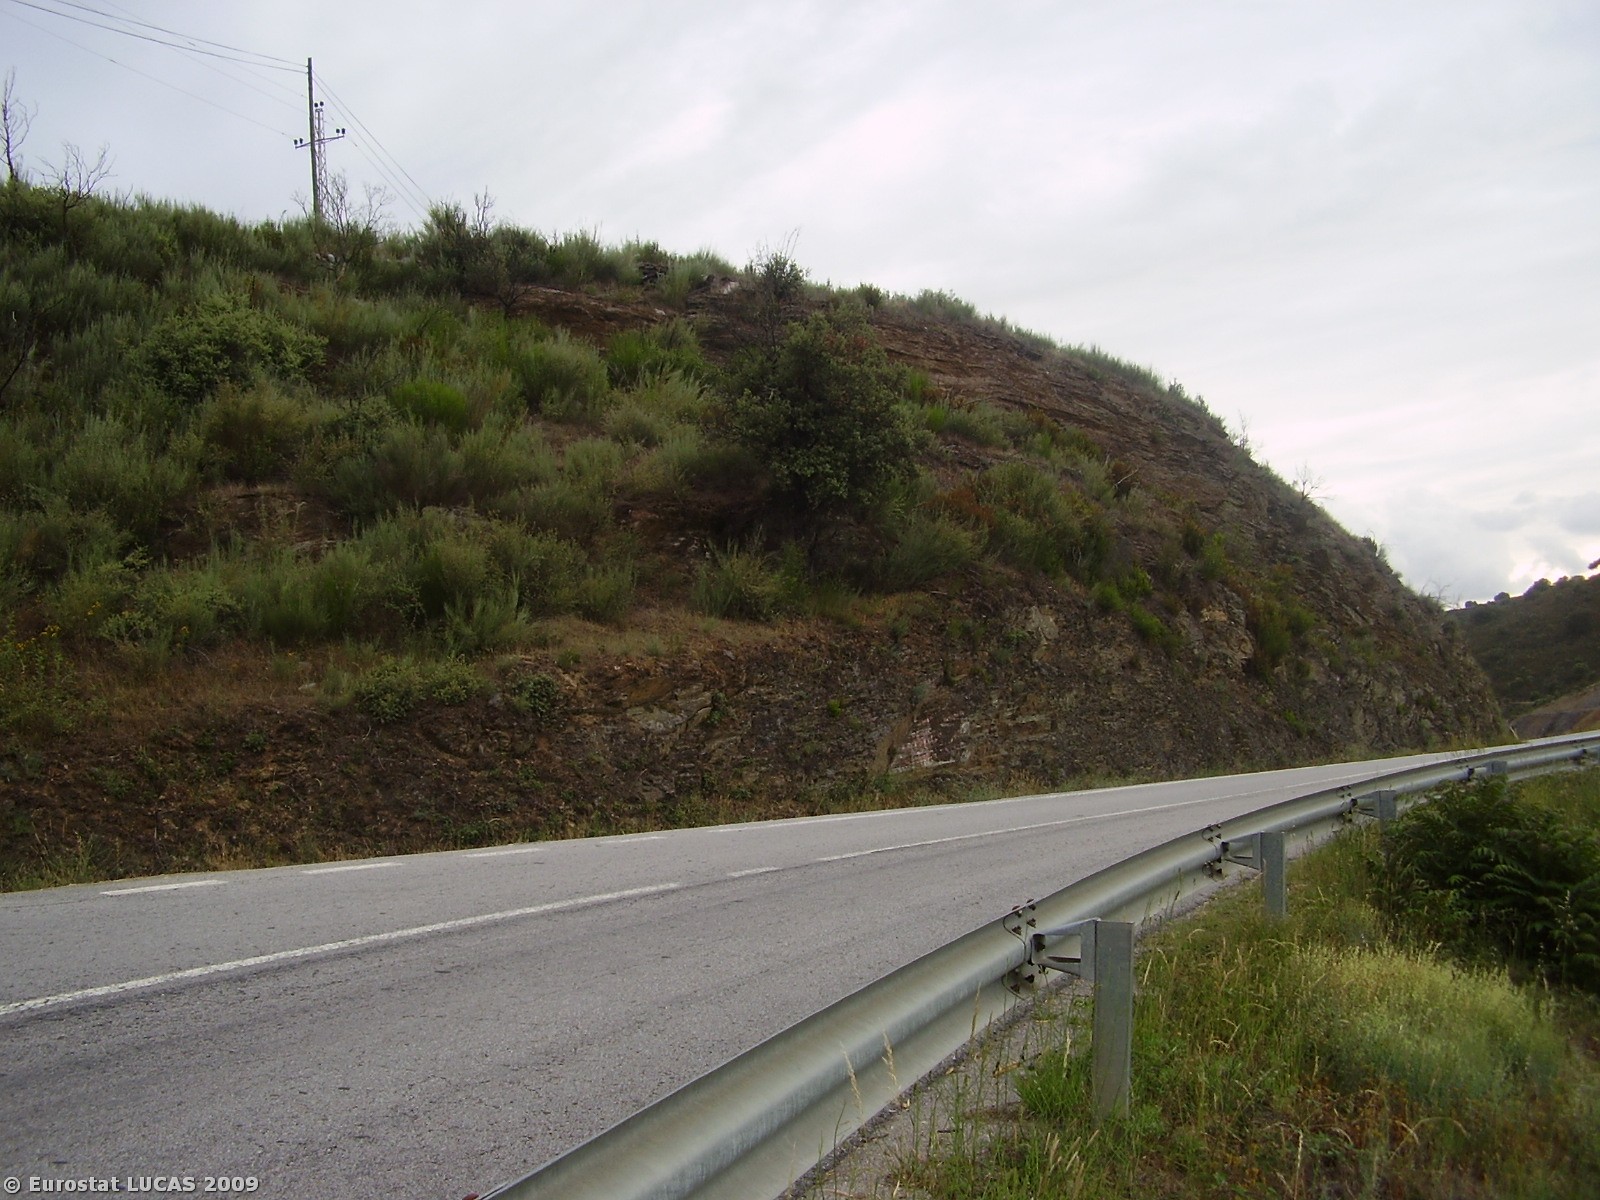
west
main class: Shrubland
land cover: Shrubland with sparse tree cover
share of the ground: > 75 %
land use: Nature reserves
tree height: > 5 m
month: June
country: PT
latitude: 41.7383
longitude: -6.5681
